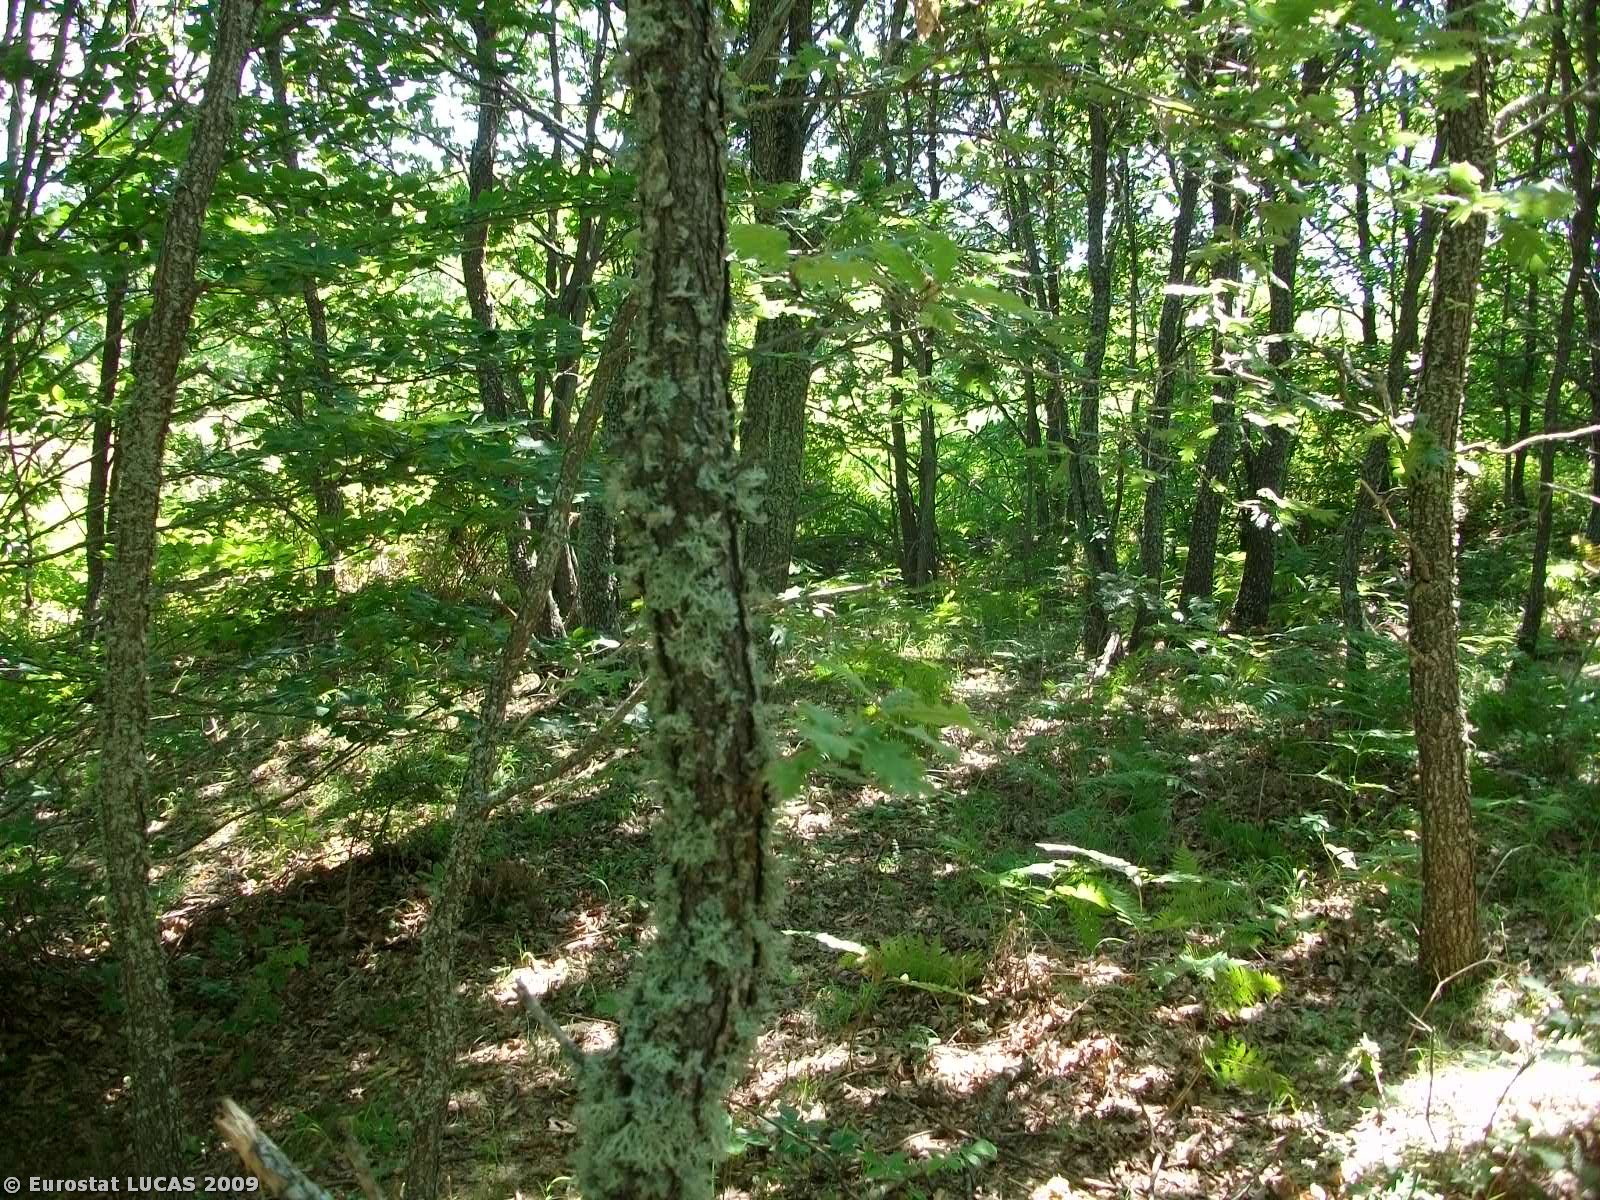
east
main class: Woodland
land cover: Broadleaved woodland
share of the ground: 50 - 75 %
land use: Nature reserves
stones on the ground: 10 - 25 %
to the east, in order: Broadleaved woodland; Shrubland with sparse tree cover; Broadleaved woodland
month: July
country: GR
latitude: 40.4272
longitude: 23.5077
